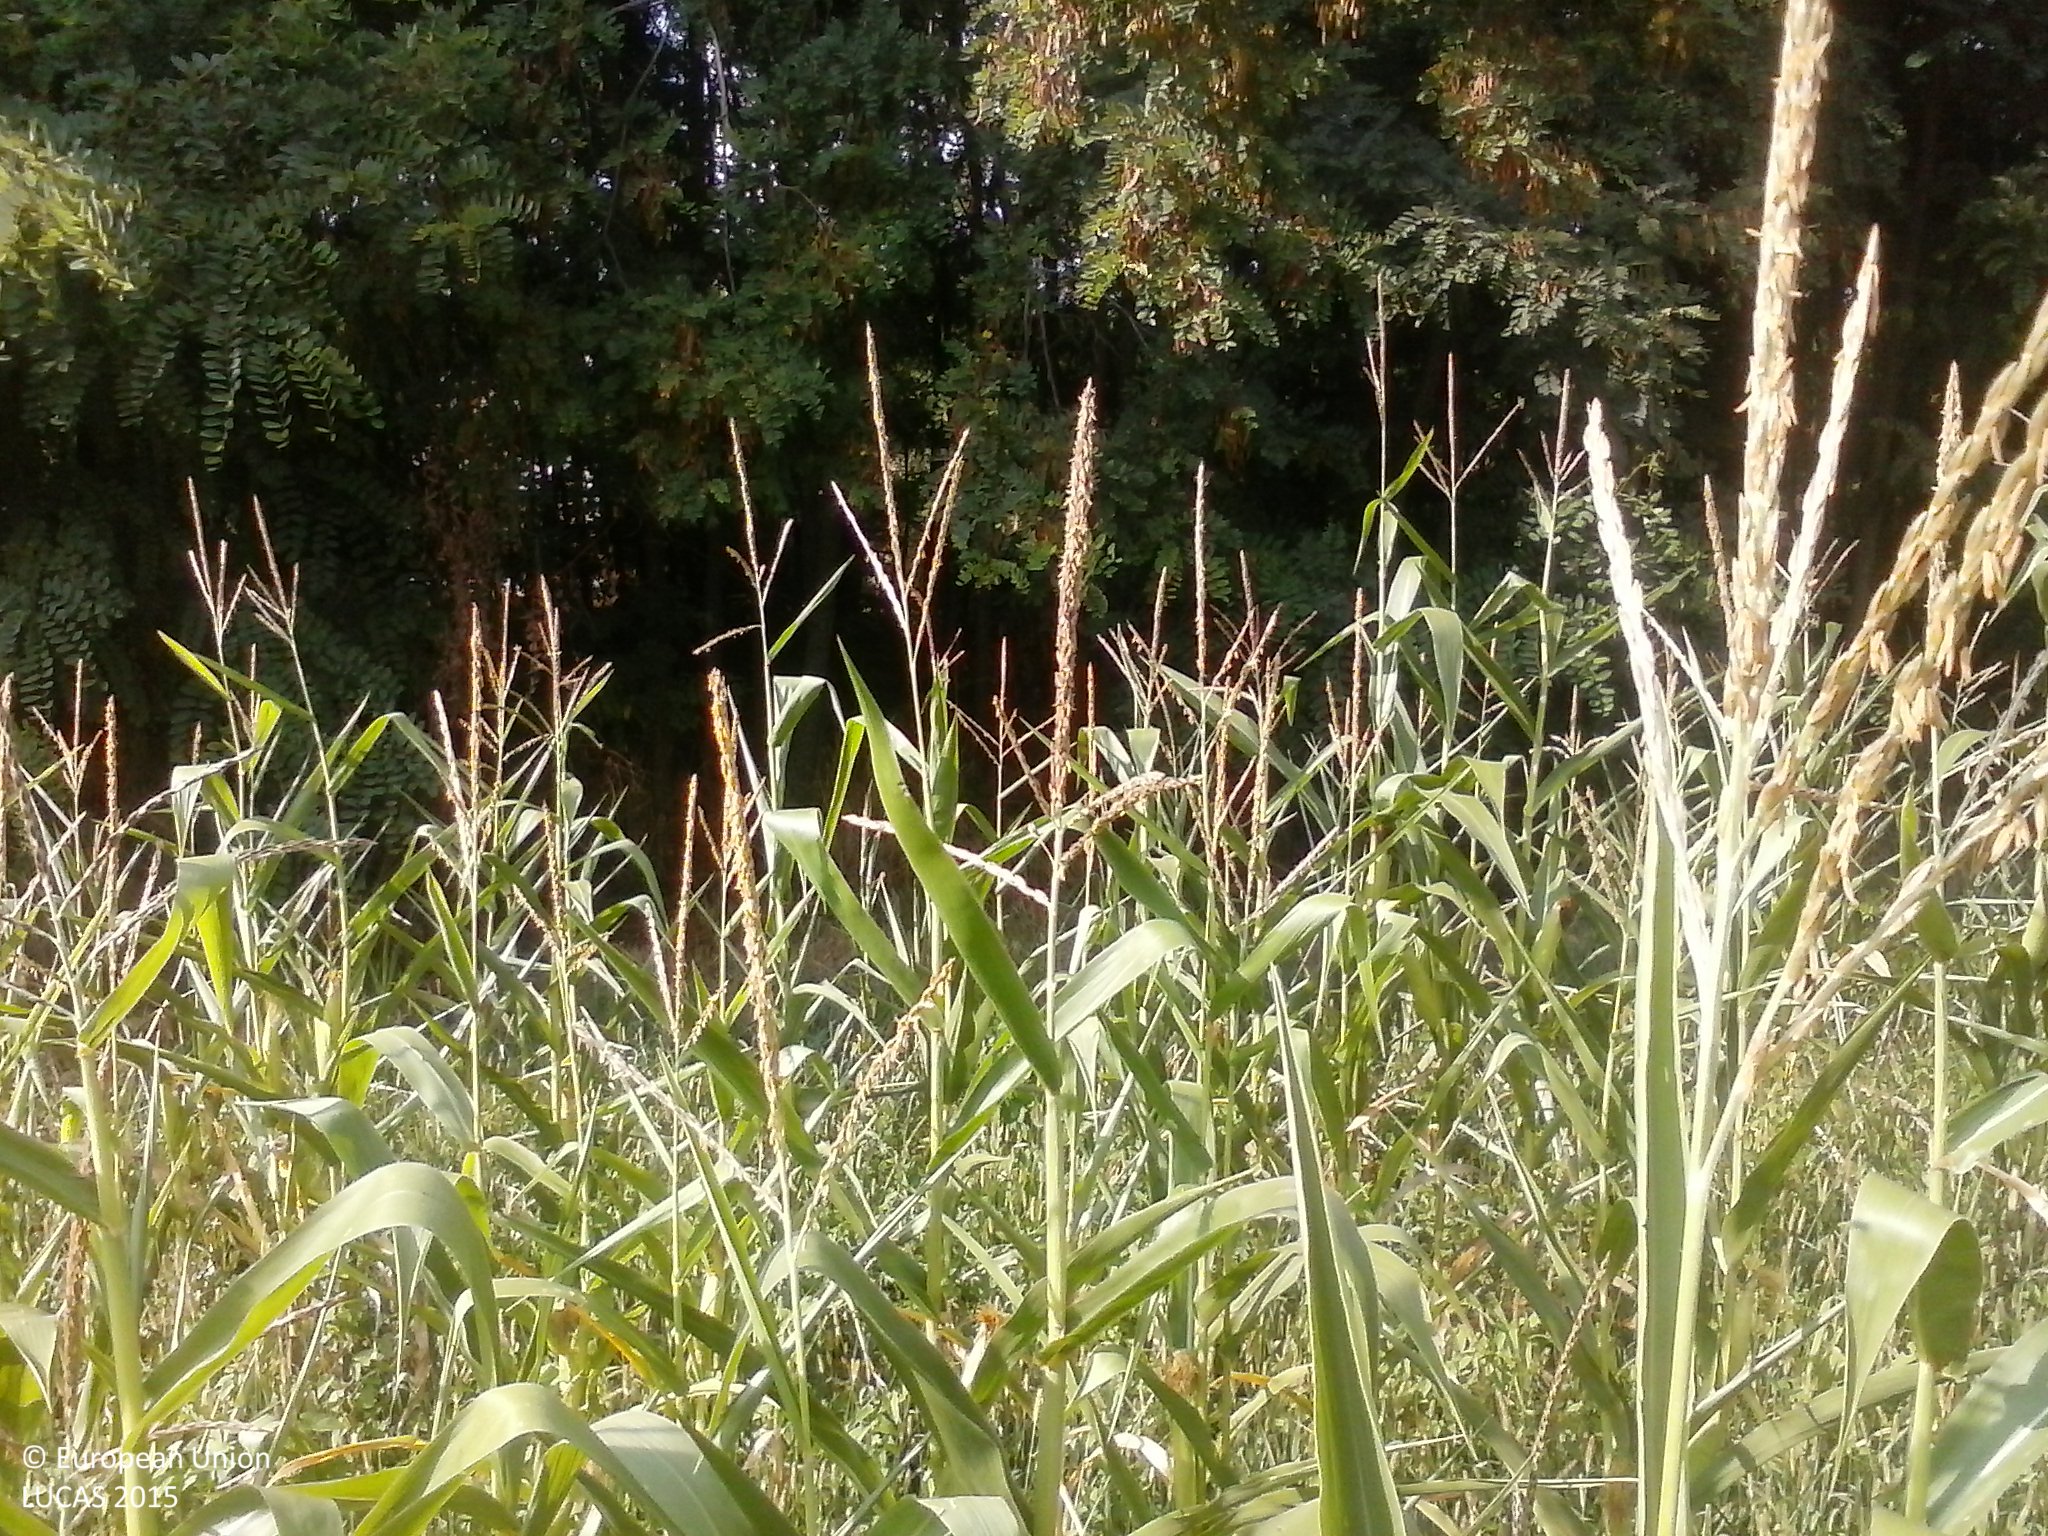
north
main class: Cropland
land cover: Maize
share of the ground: > 75 %
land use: Agriculture (excluding fallow land and kitchen gardens)
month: August
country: HU
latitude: 46.0859
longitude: 17.7772
